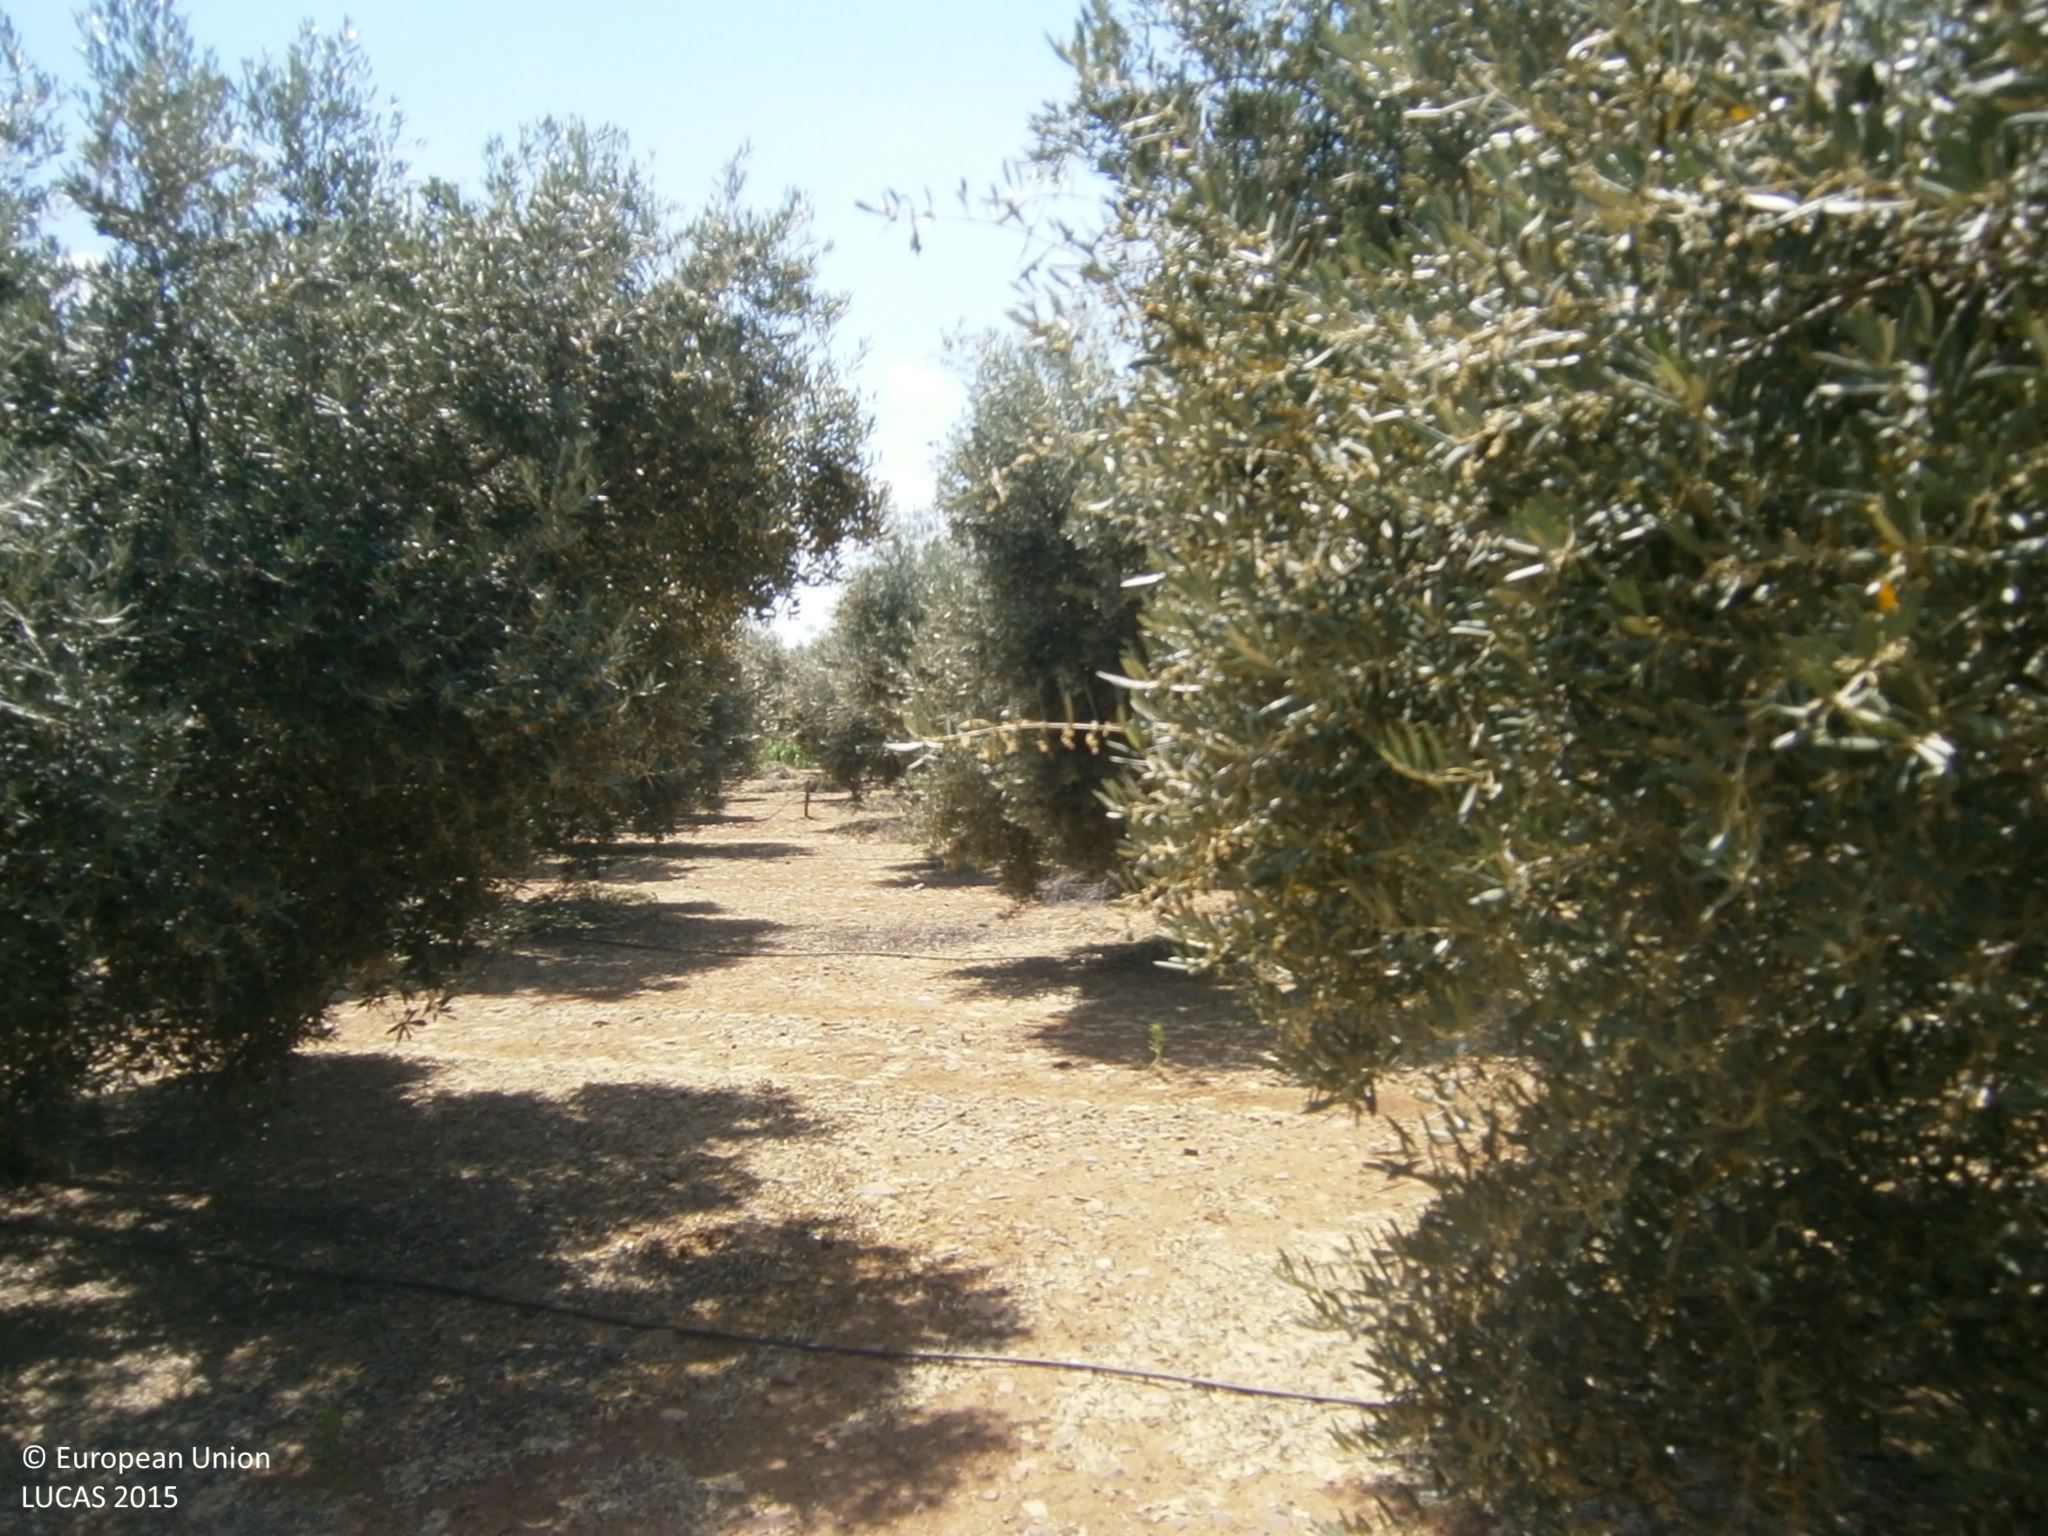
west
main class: Cropland
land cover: Olive groves
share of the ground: 50 - 75 %
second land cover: Spontaneously vegetated surfaces
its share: > 75 %
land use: Agriculture (excluding fallow land and kitchen gardens)
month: June
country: ES
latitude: 38.8344
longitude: -6.2162
